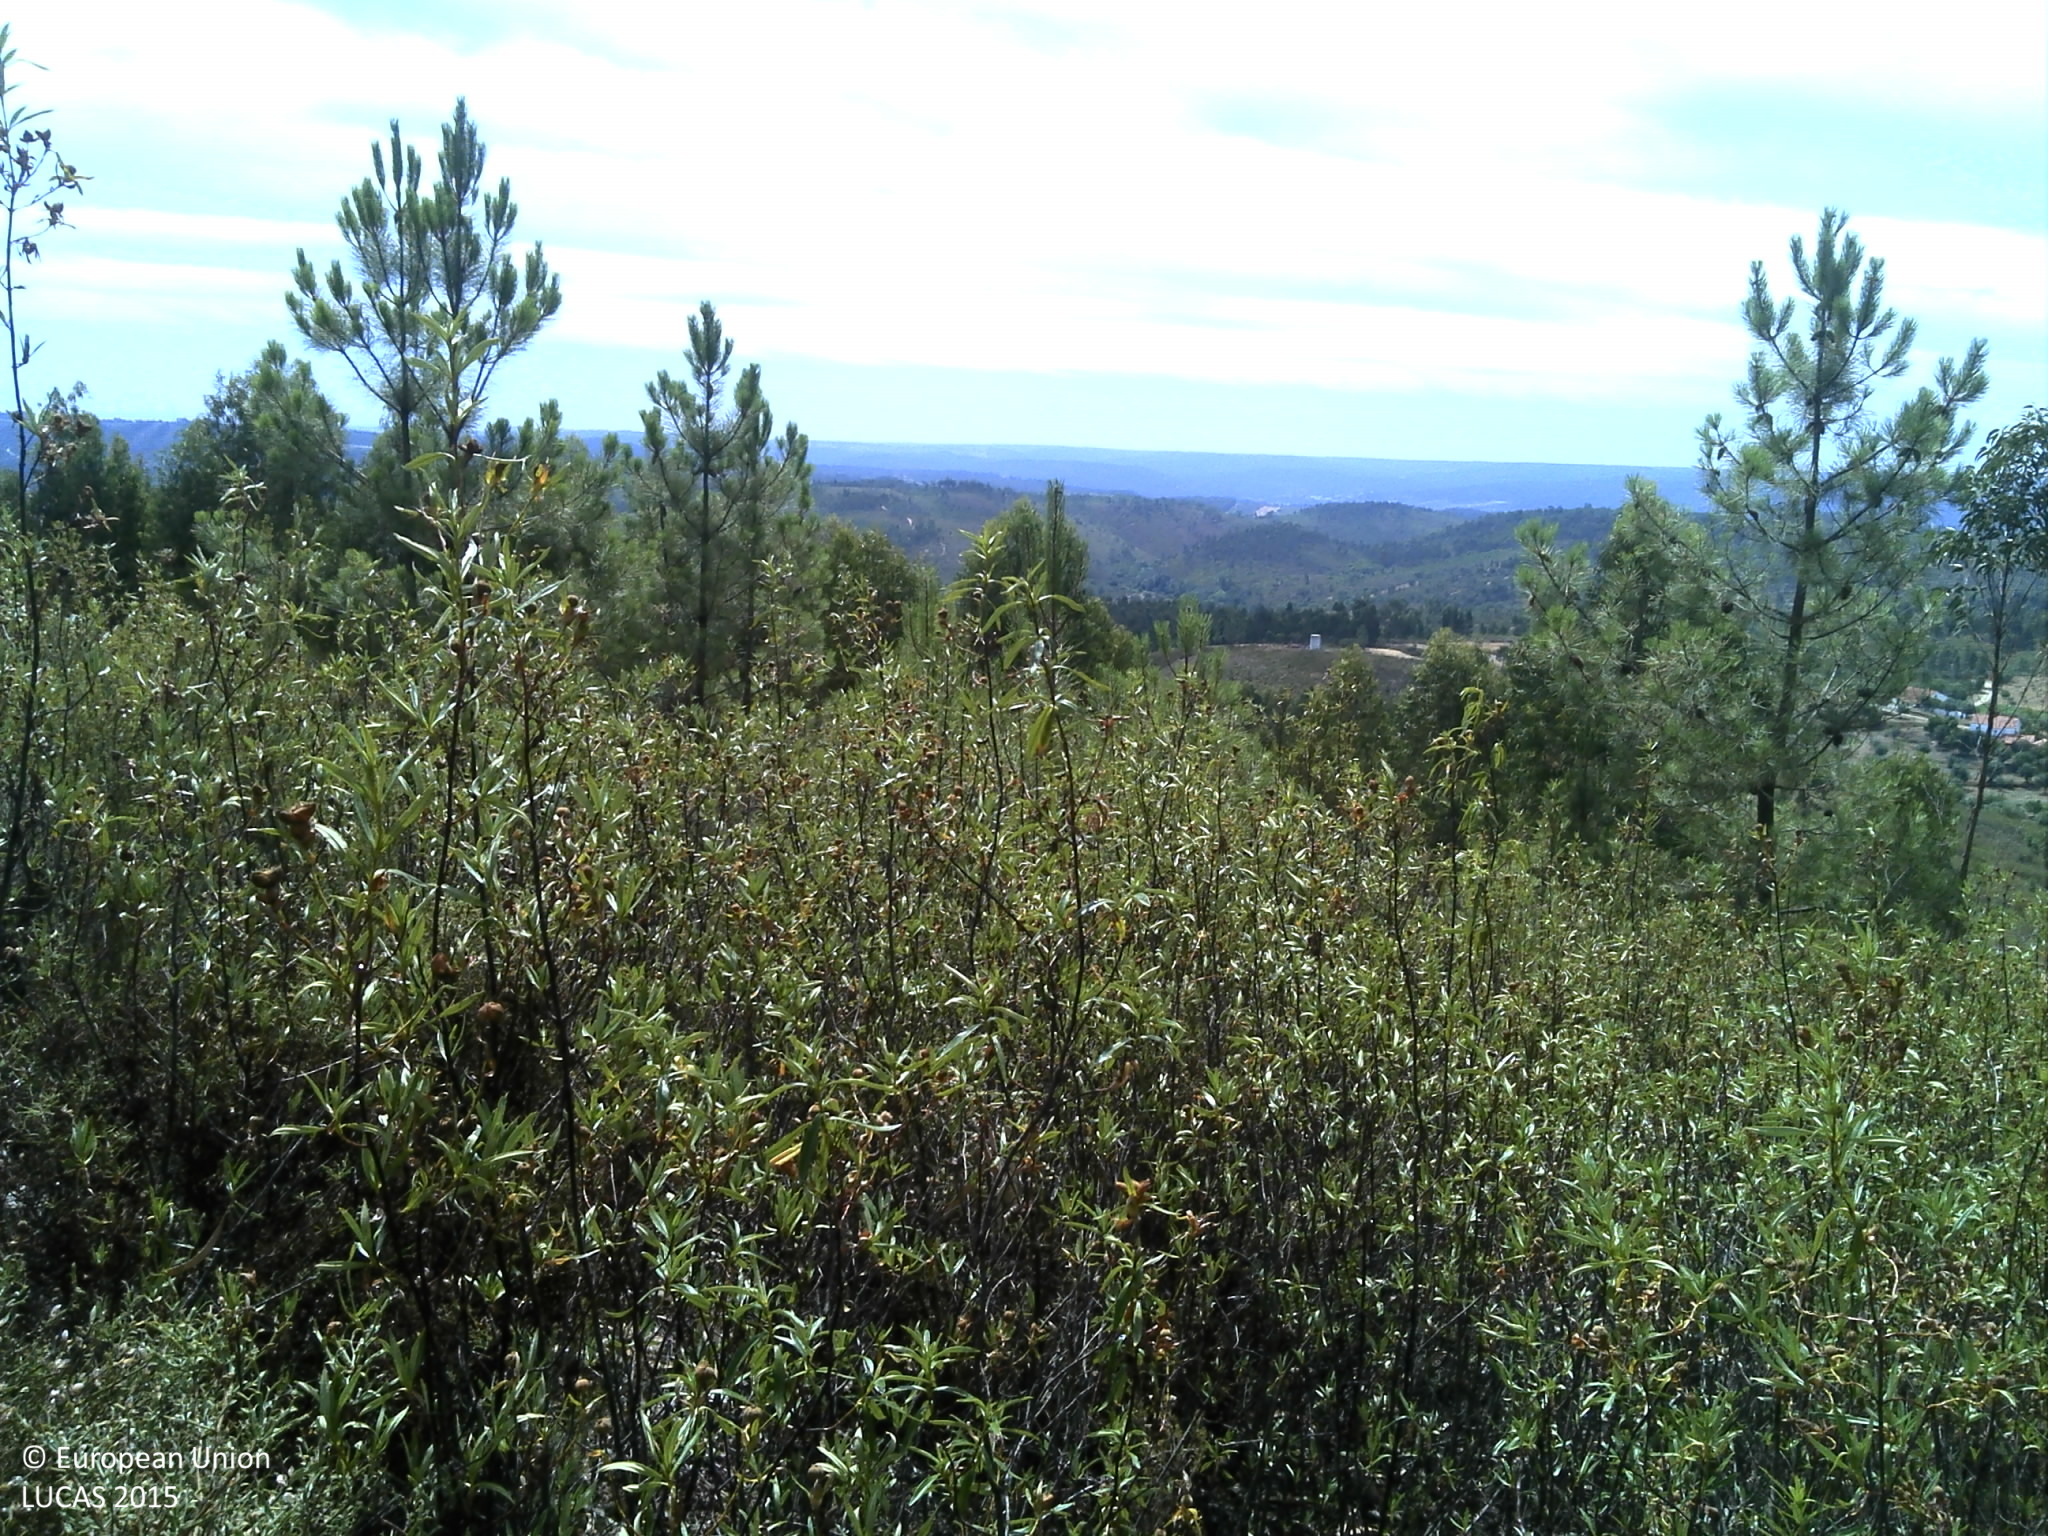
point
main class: Shrubland
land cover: Shrubland with sparse tree cover
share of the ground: > 75 %
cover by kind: shrubs 90 %, broadleaved forest trees 5 %, unconsolidated bare surface 5 %
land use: Abandoned areas
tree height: > 5 m
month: July
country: PT
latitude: 39.5148
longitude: -8.0786
